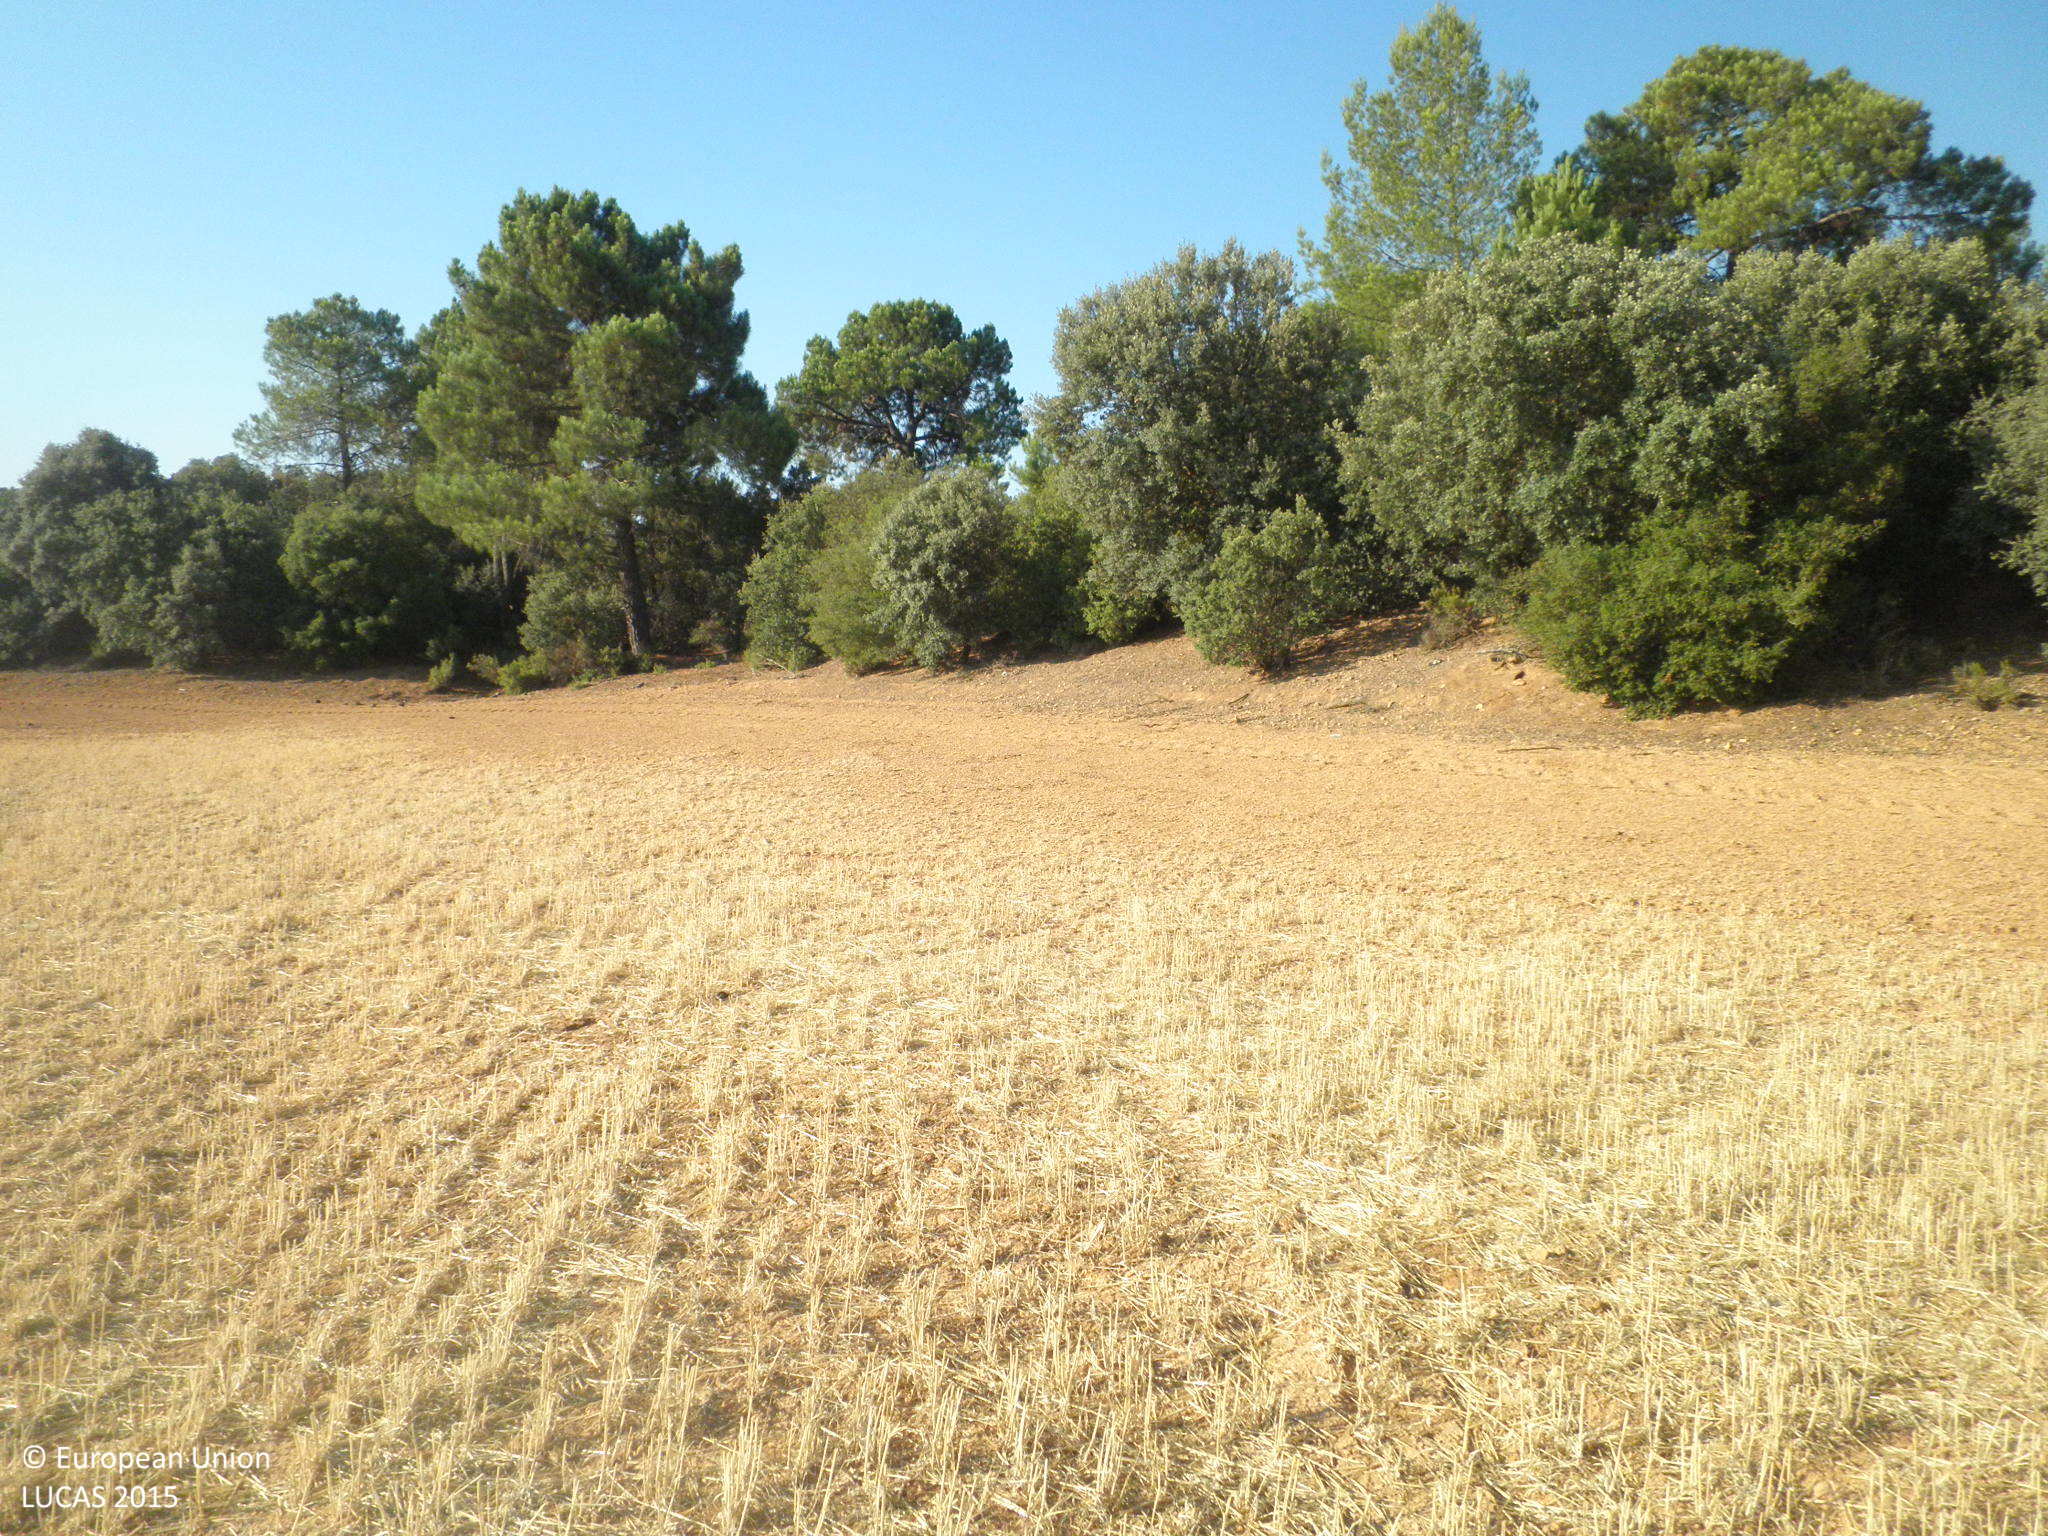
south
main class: Cropland
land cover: Barley
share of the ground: < 10 %
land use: Agriculture (excluding fallow land and kitchen gardens)
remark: Harvested field
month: July
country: ES
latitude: 39.5106
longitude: -1.6944
